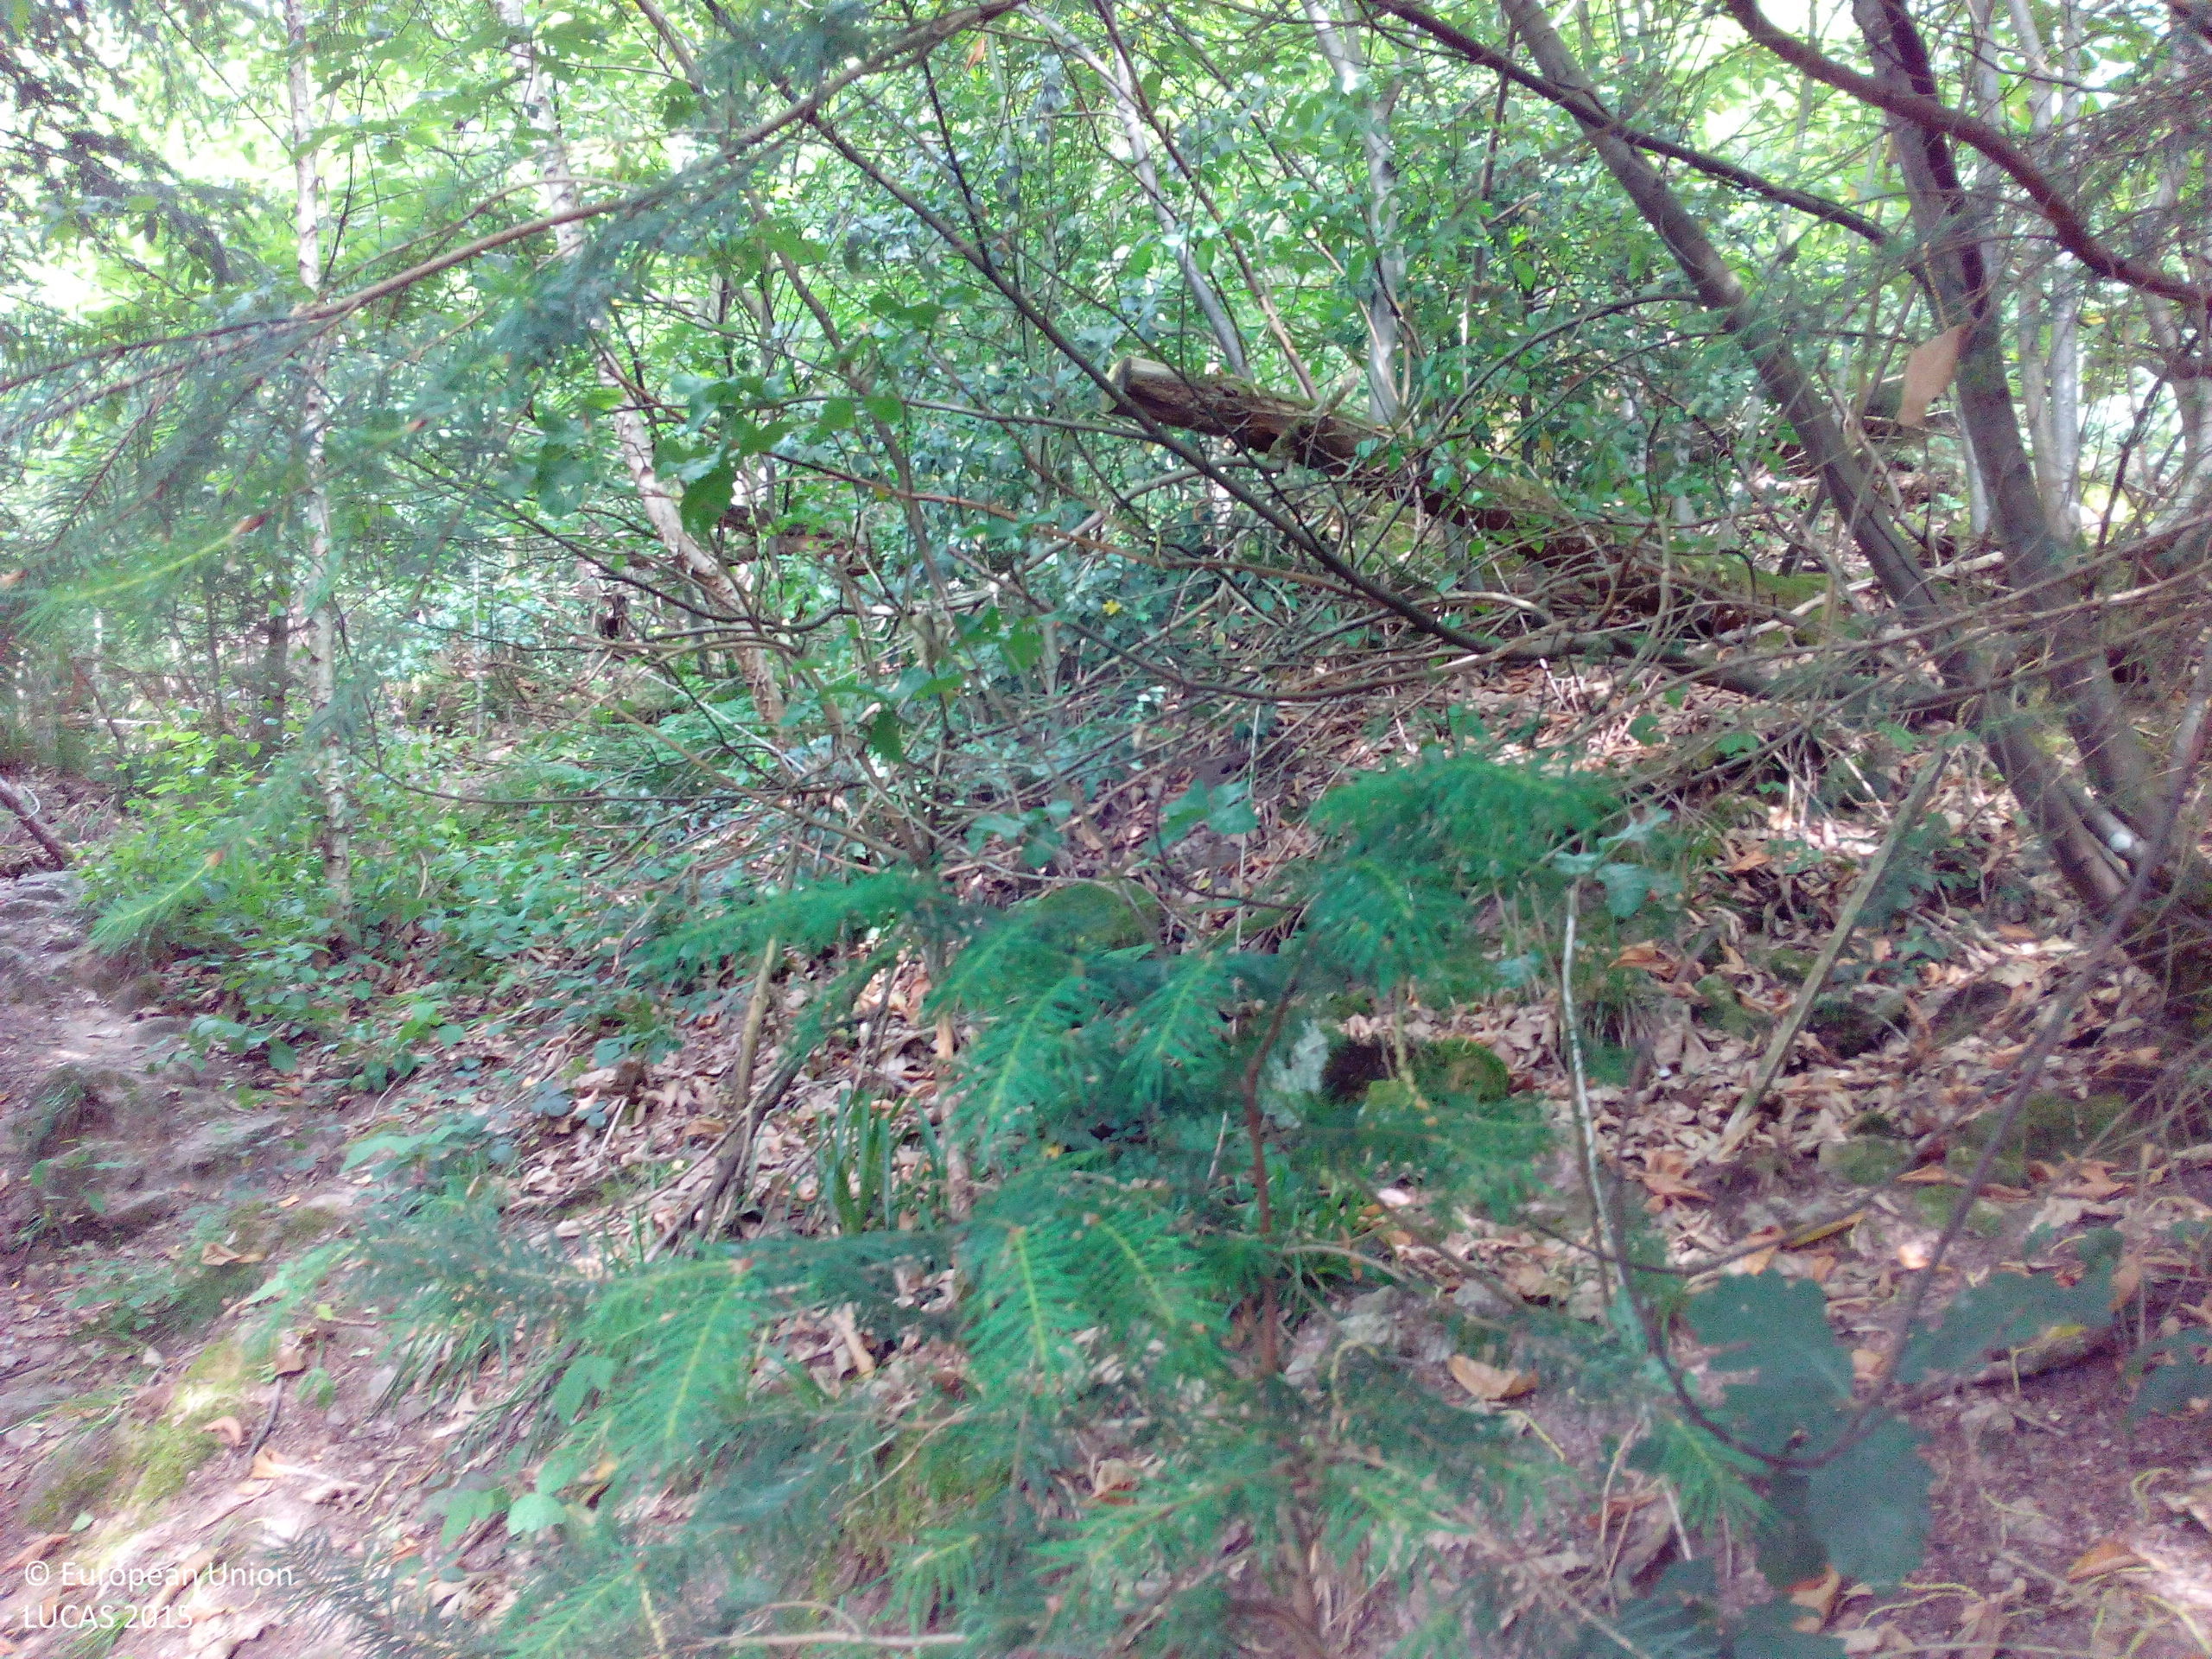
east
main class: Woodland
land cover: Spruce dominated mixed woodland
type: hemiboreal forest and nemoral coniferous forest and mixed broadleaved-coniferous forest
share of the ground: > 75 %
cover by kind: coniferous forest trees 60 %, broadleaved forest trees 40 %
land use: Forestry
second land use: Amenities, museums, leisure
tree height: > 5 m
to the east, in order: Spruce dominated mixed woodland; Other mixed woodland; Tracks; Other mixed woodland; Spruce dominated mixed woodland
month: June
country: DE
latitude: 48.7307
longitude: 8.1925
